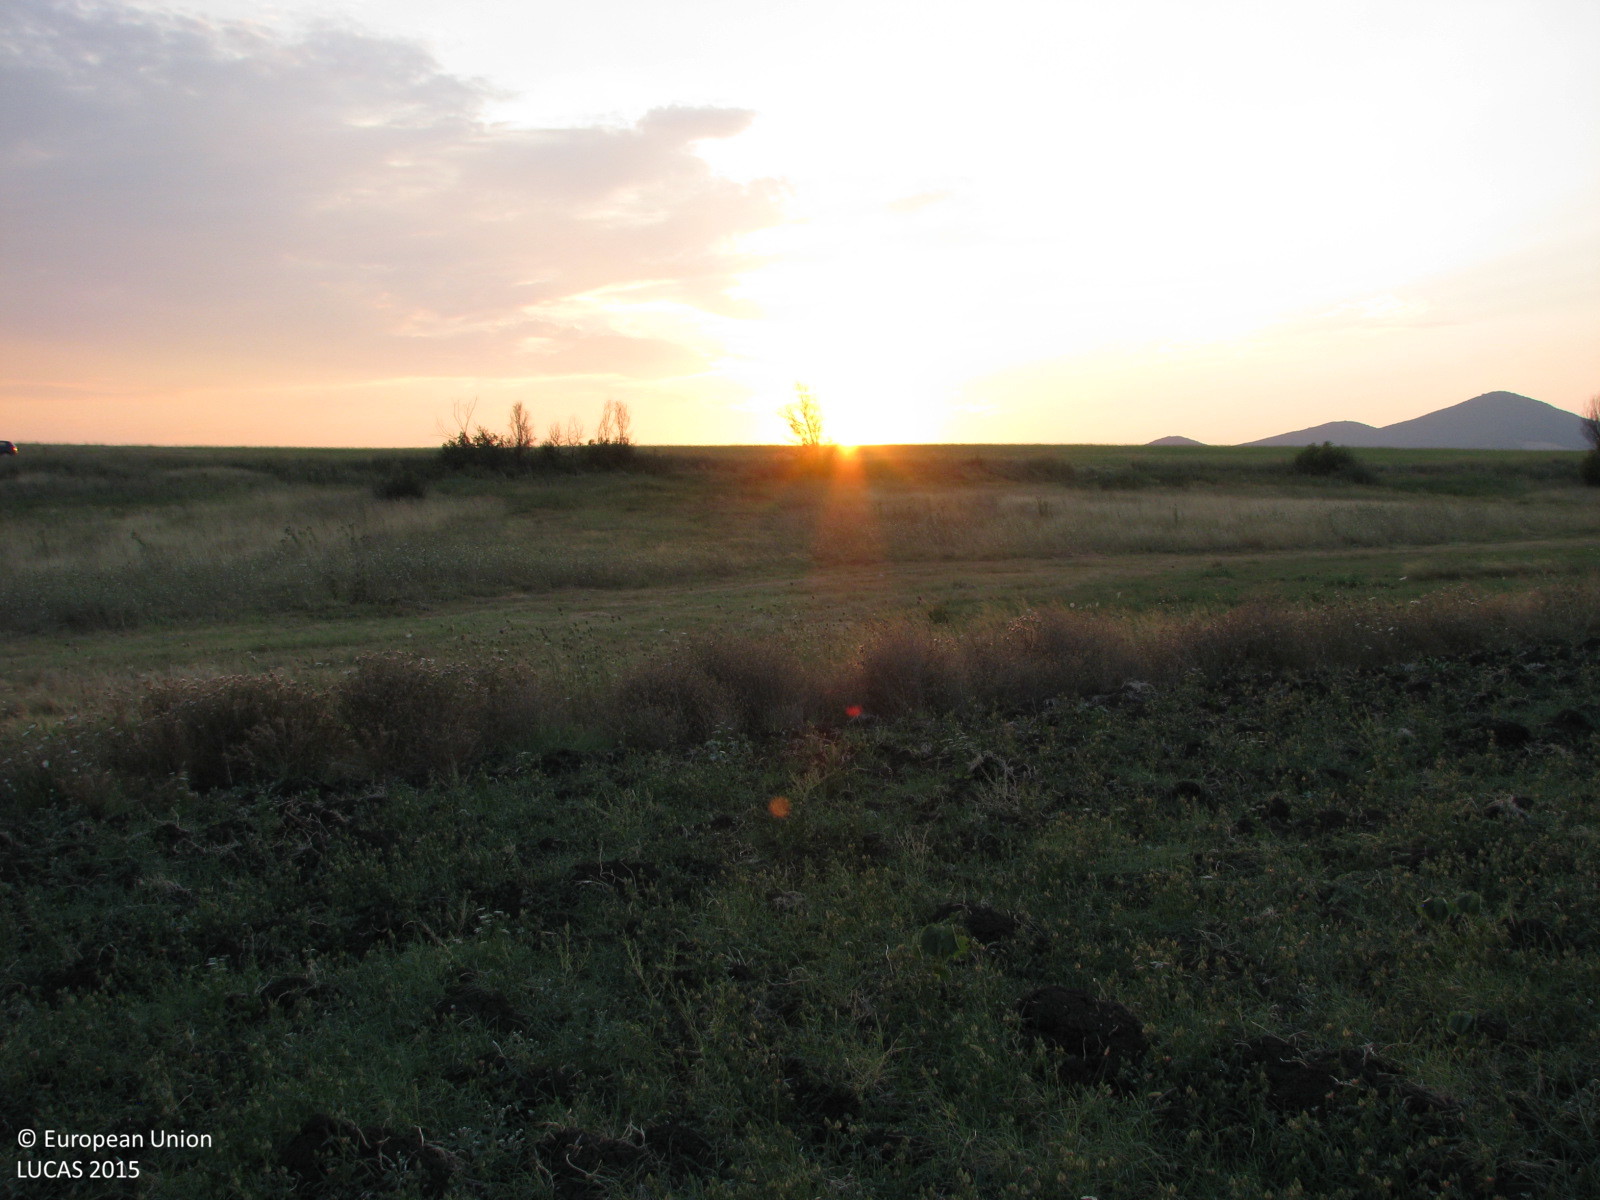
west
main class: Grassland
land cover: Spontaneously vegetated surfaces
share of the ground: > 75 %
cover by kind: herbaceous plants 90 %, unconsolidated bare surface 10 %
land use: Agriculture (excluding fallow land and kitchen gardens)
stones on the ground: < 10 %
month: August
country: BG
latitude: 42.1899
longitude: 26.3965
